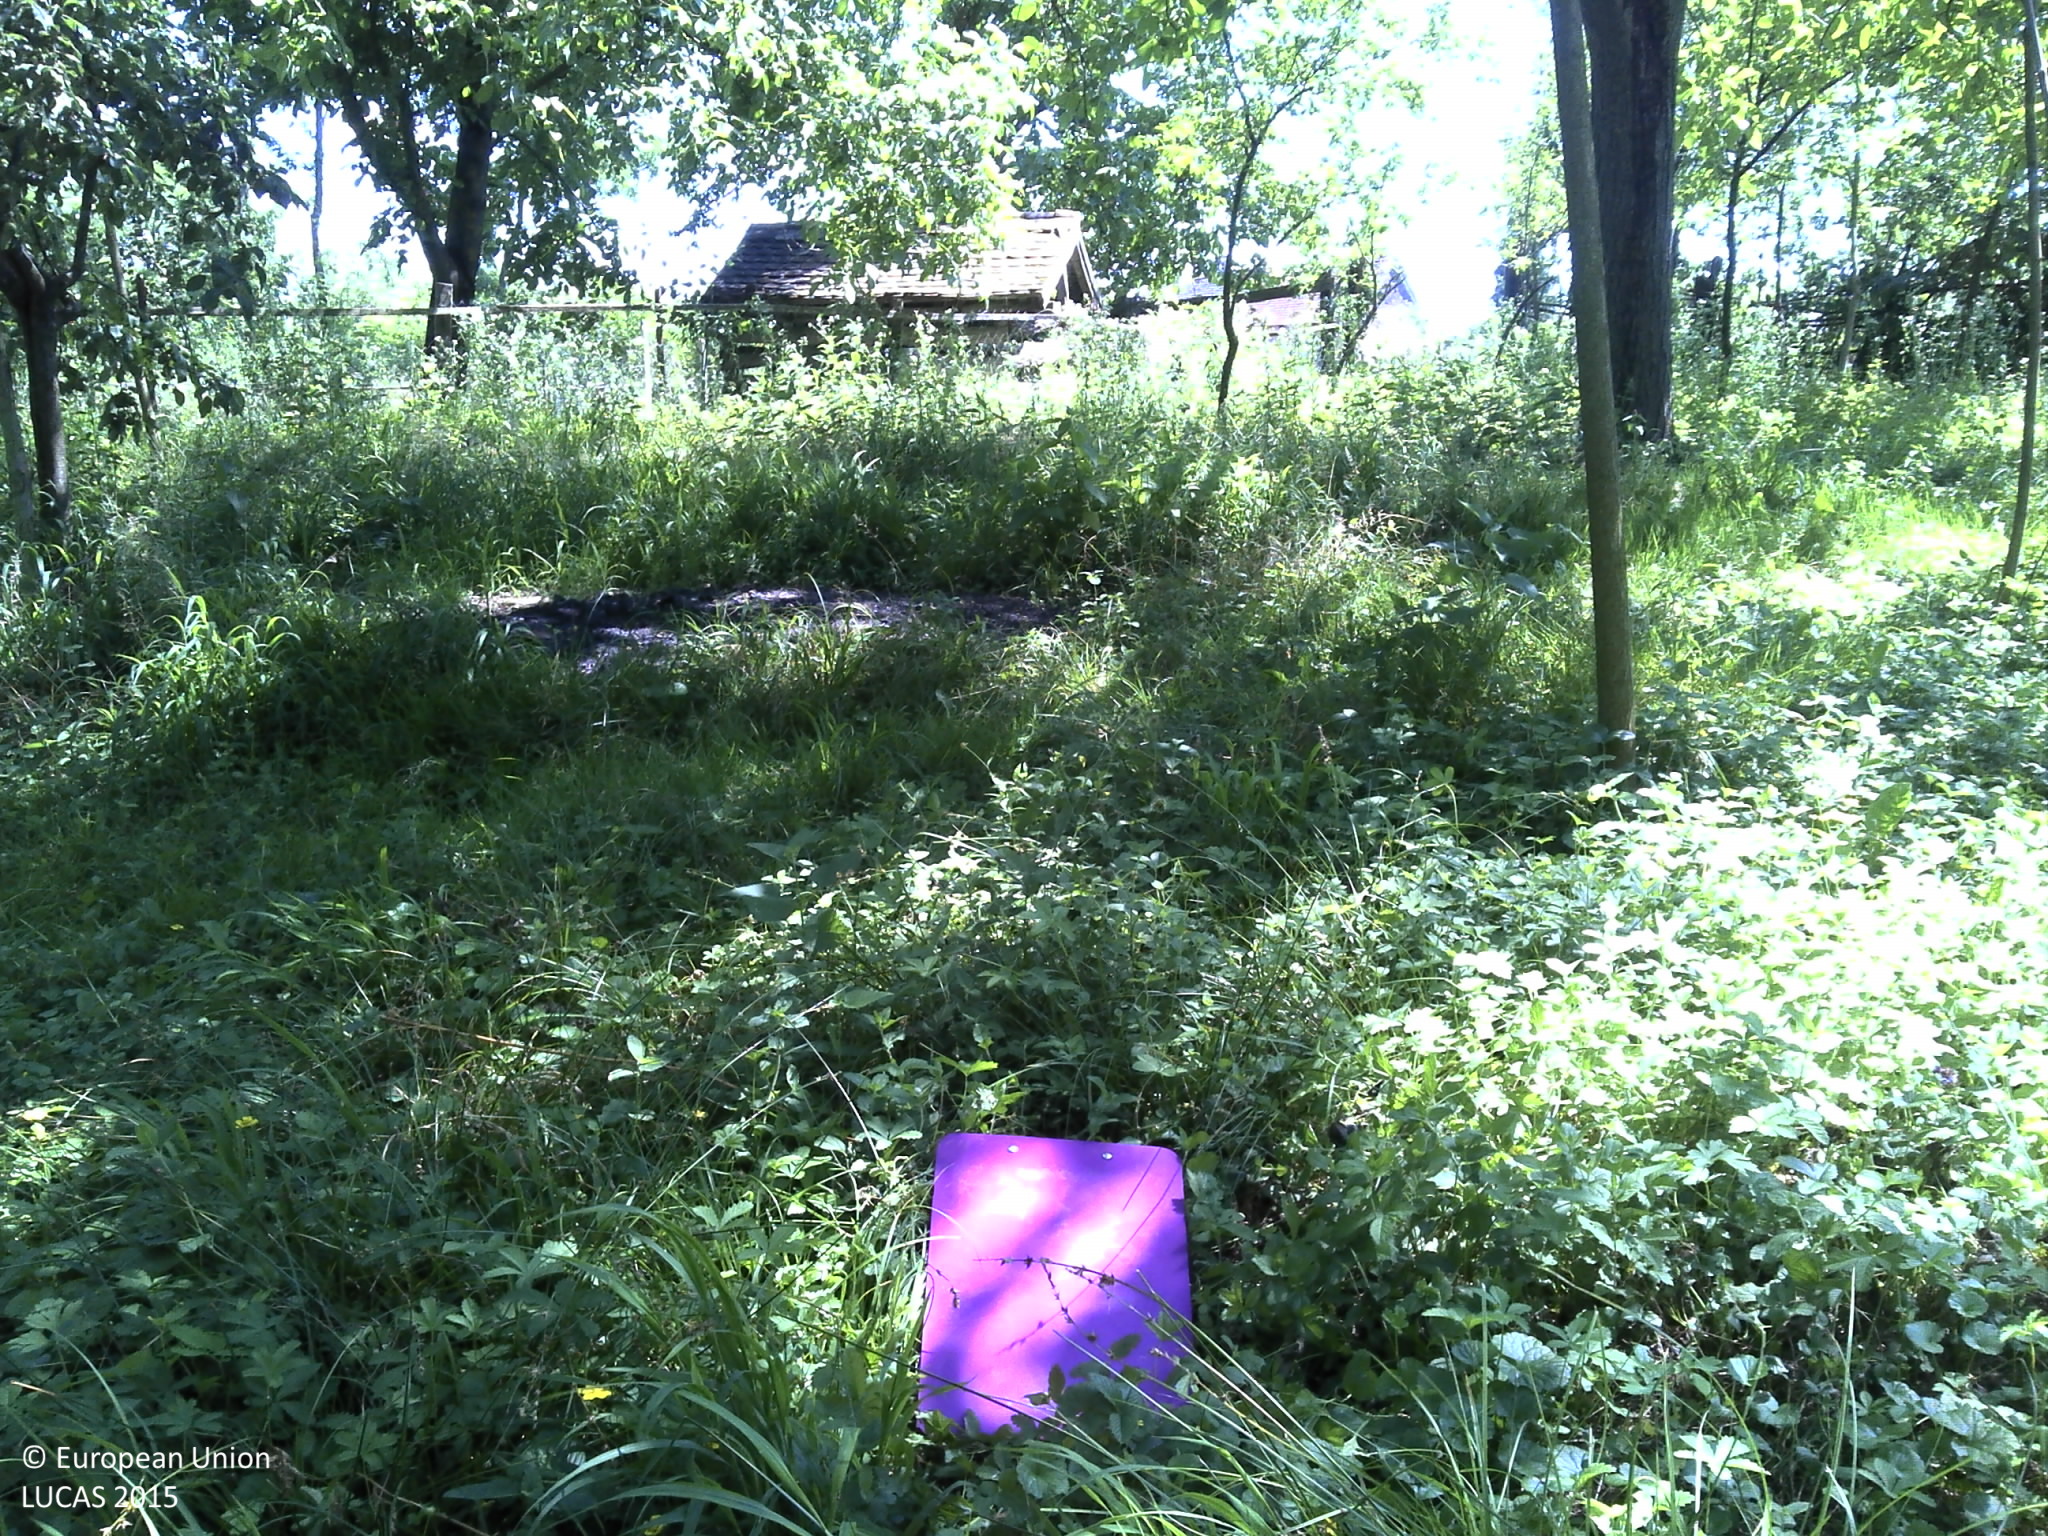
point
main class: Grassland
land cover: Grassland with sparse tree/shrub cover
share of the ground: > 75 %
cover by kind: herbaceous plants 95 %, broadleaved forest trees 5 %
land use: Semi-natural and natural areas not in use
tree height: < 5 m
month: June
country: HR
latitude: 45.7429
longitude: 18.2447
